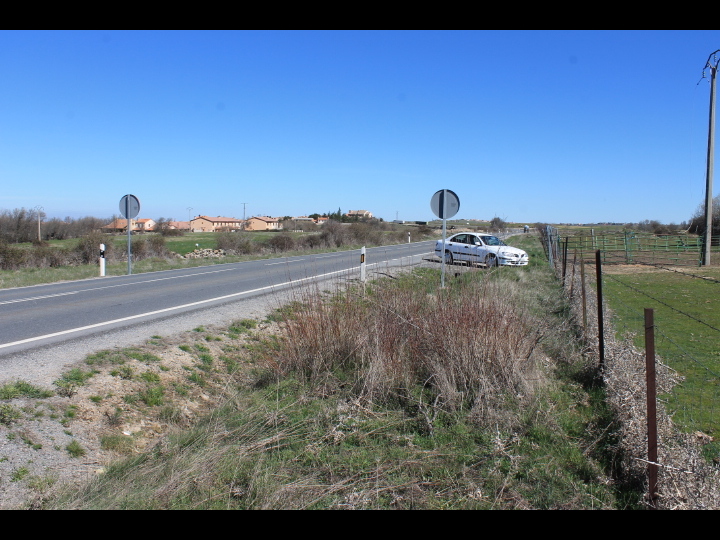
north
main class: Grassland
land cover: Grassland without tree/shrub cover
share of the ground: > 75 %
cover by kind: herbaceous plants 95 %, unconsolidated bare surface 5 %
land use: Agriculture (excluding fallow land and kitchen gardens)
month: April
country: ES
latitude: 40.9575
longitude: -4.0329
